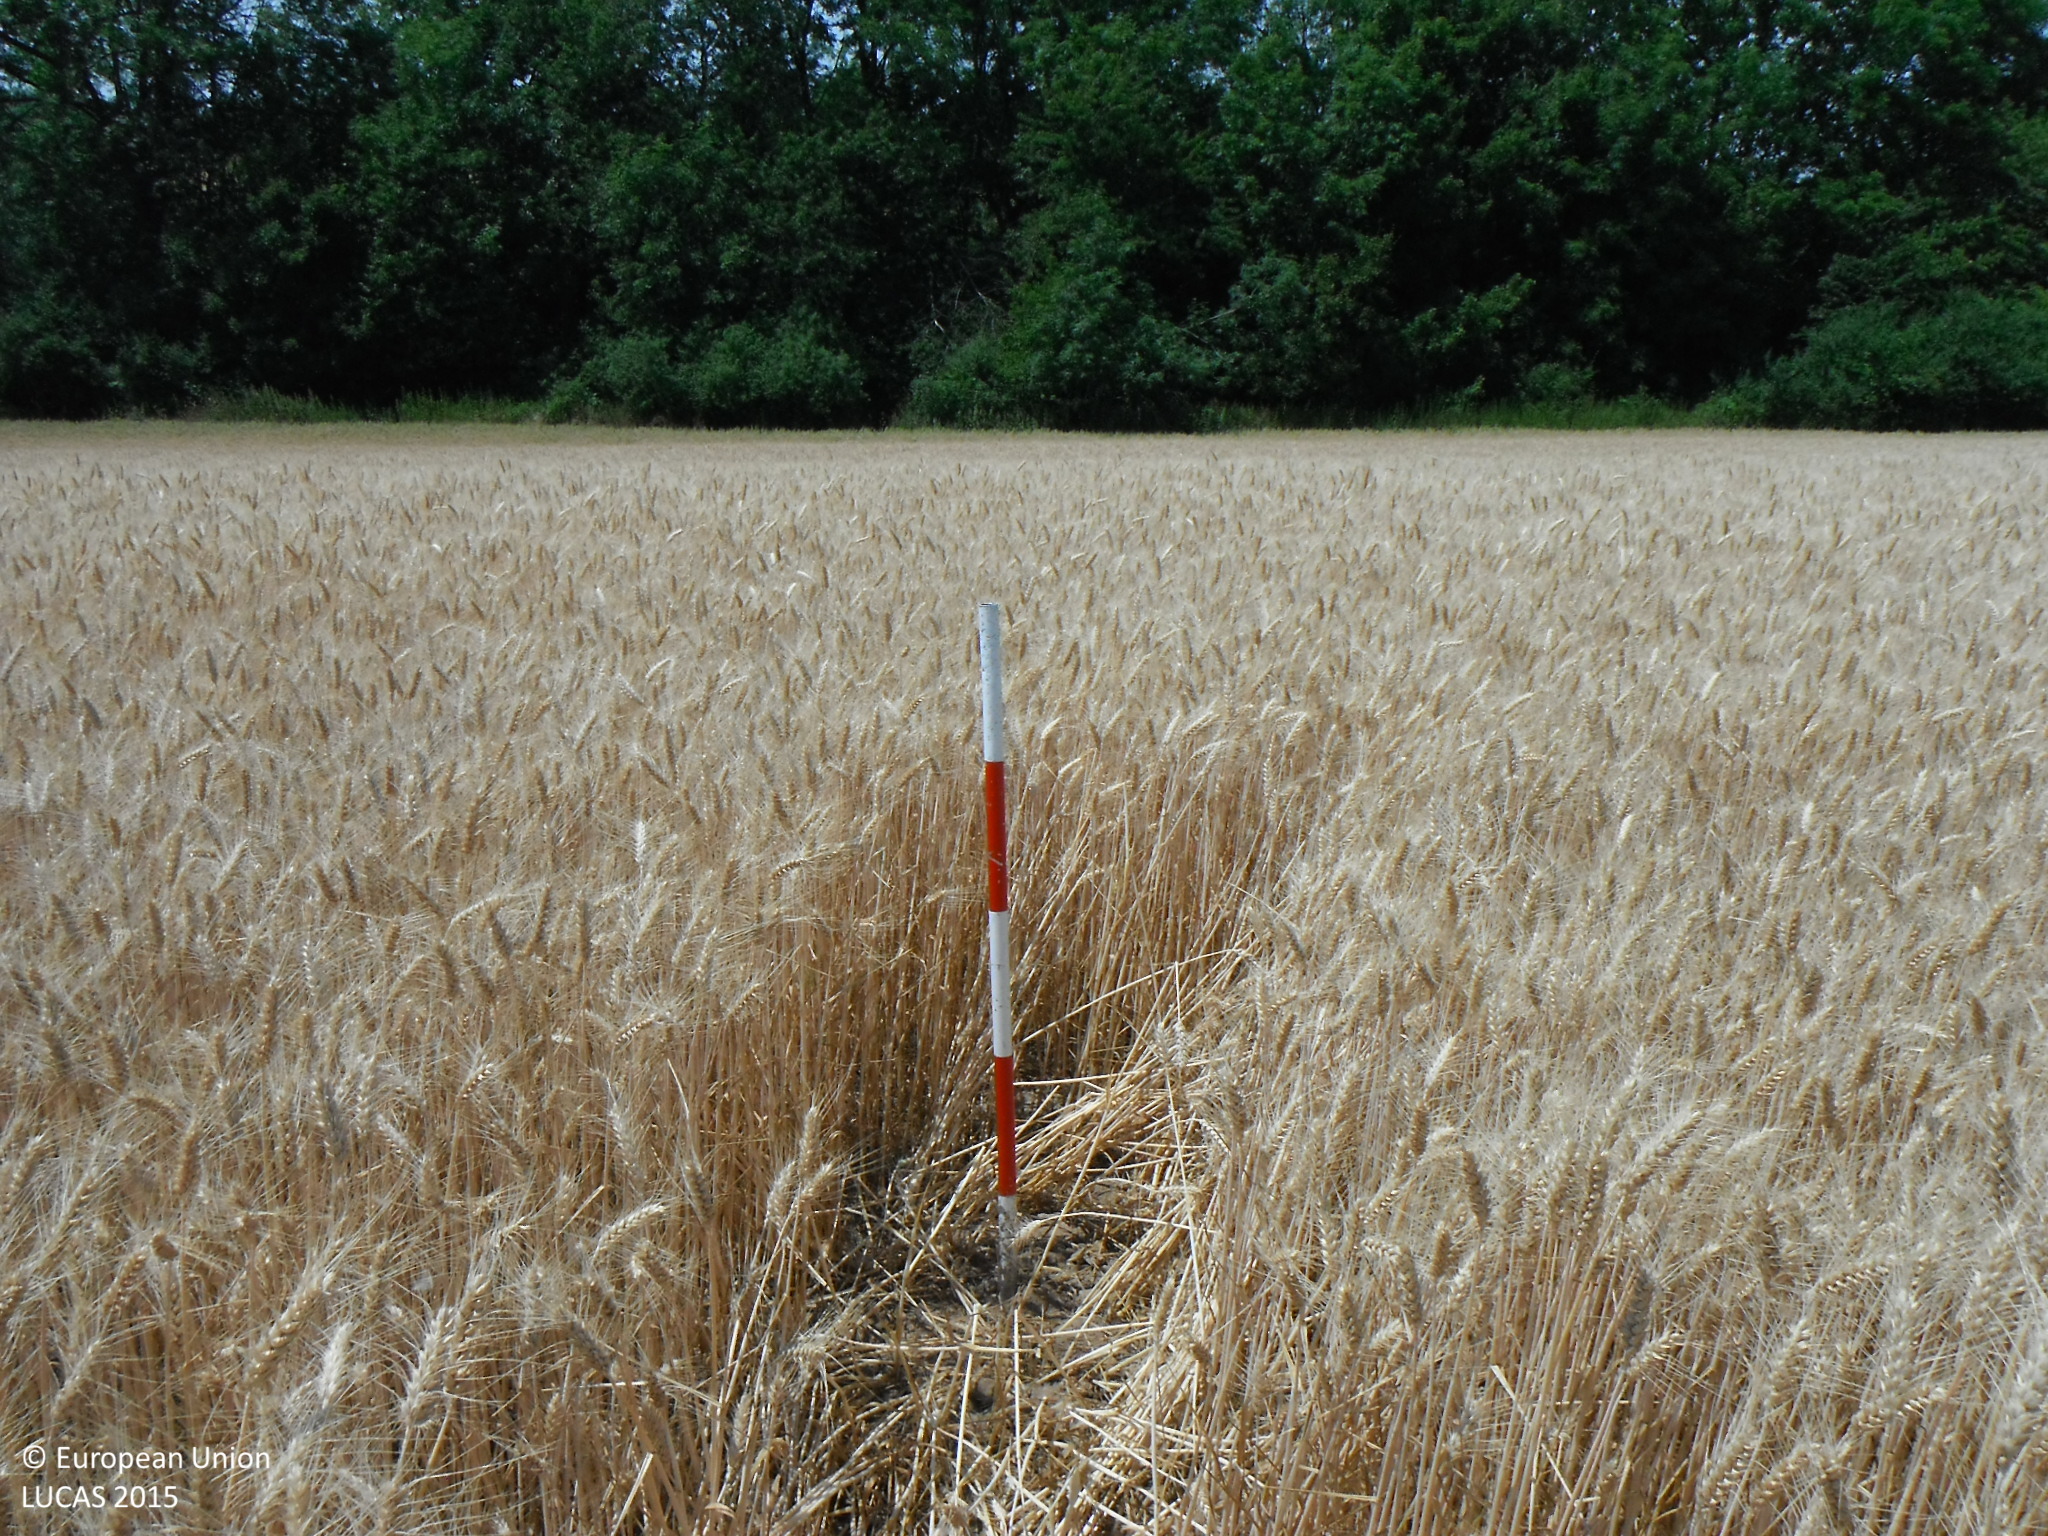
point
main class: Cropland
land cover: Common wheat
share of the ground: > 75 %
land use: Agriculture (excluding fallow land and kitchen gardens)
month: July
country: SK
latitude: 48.2061
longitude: 19.1307
